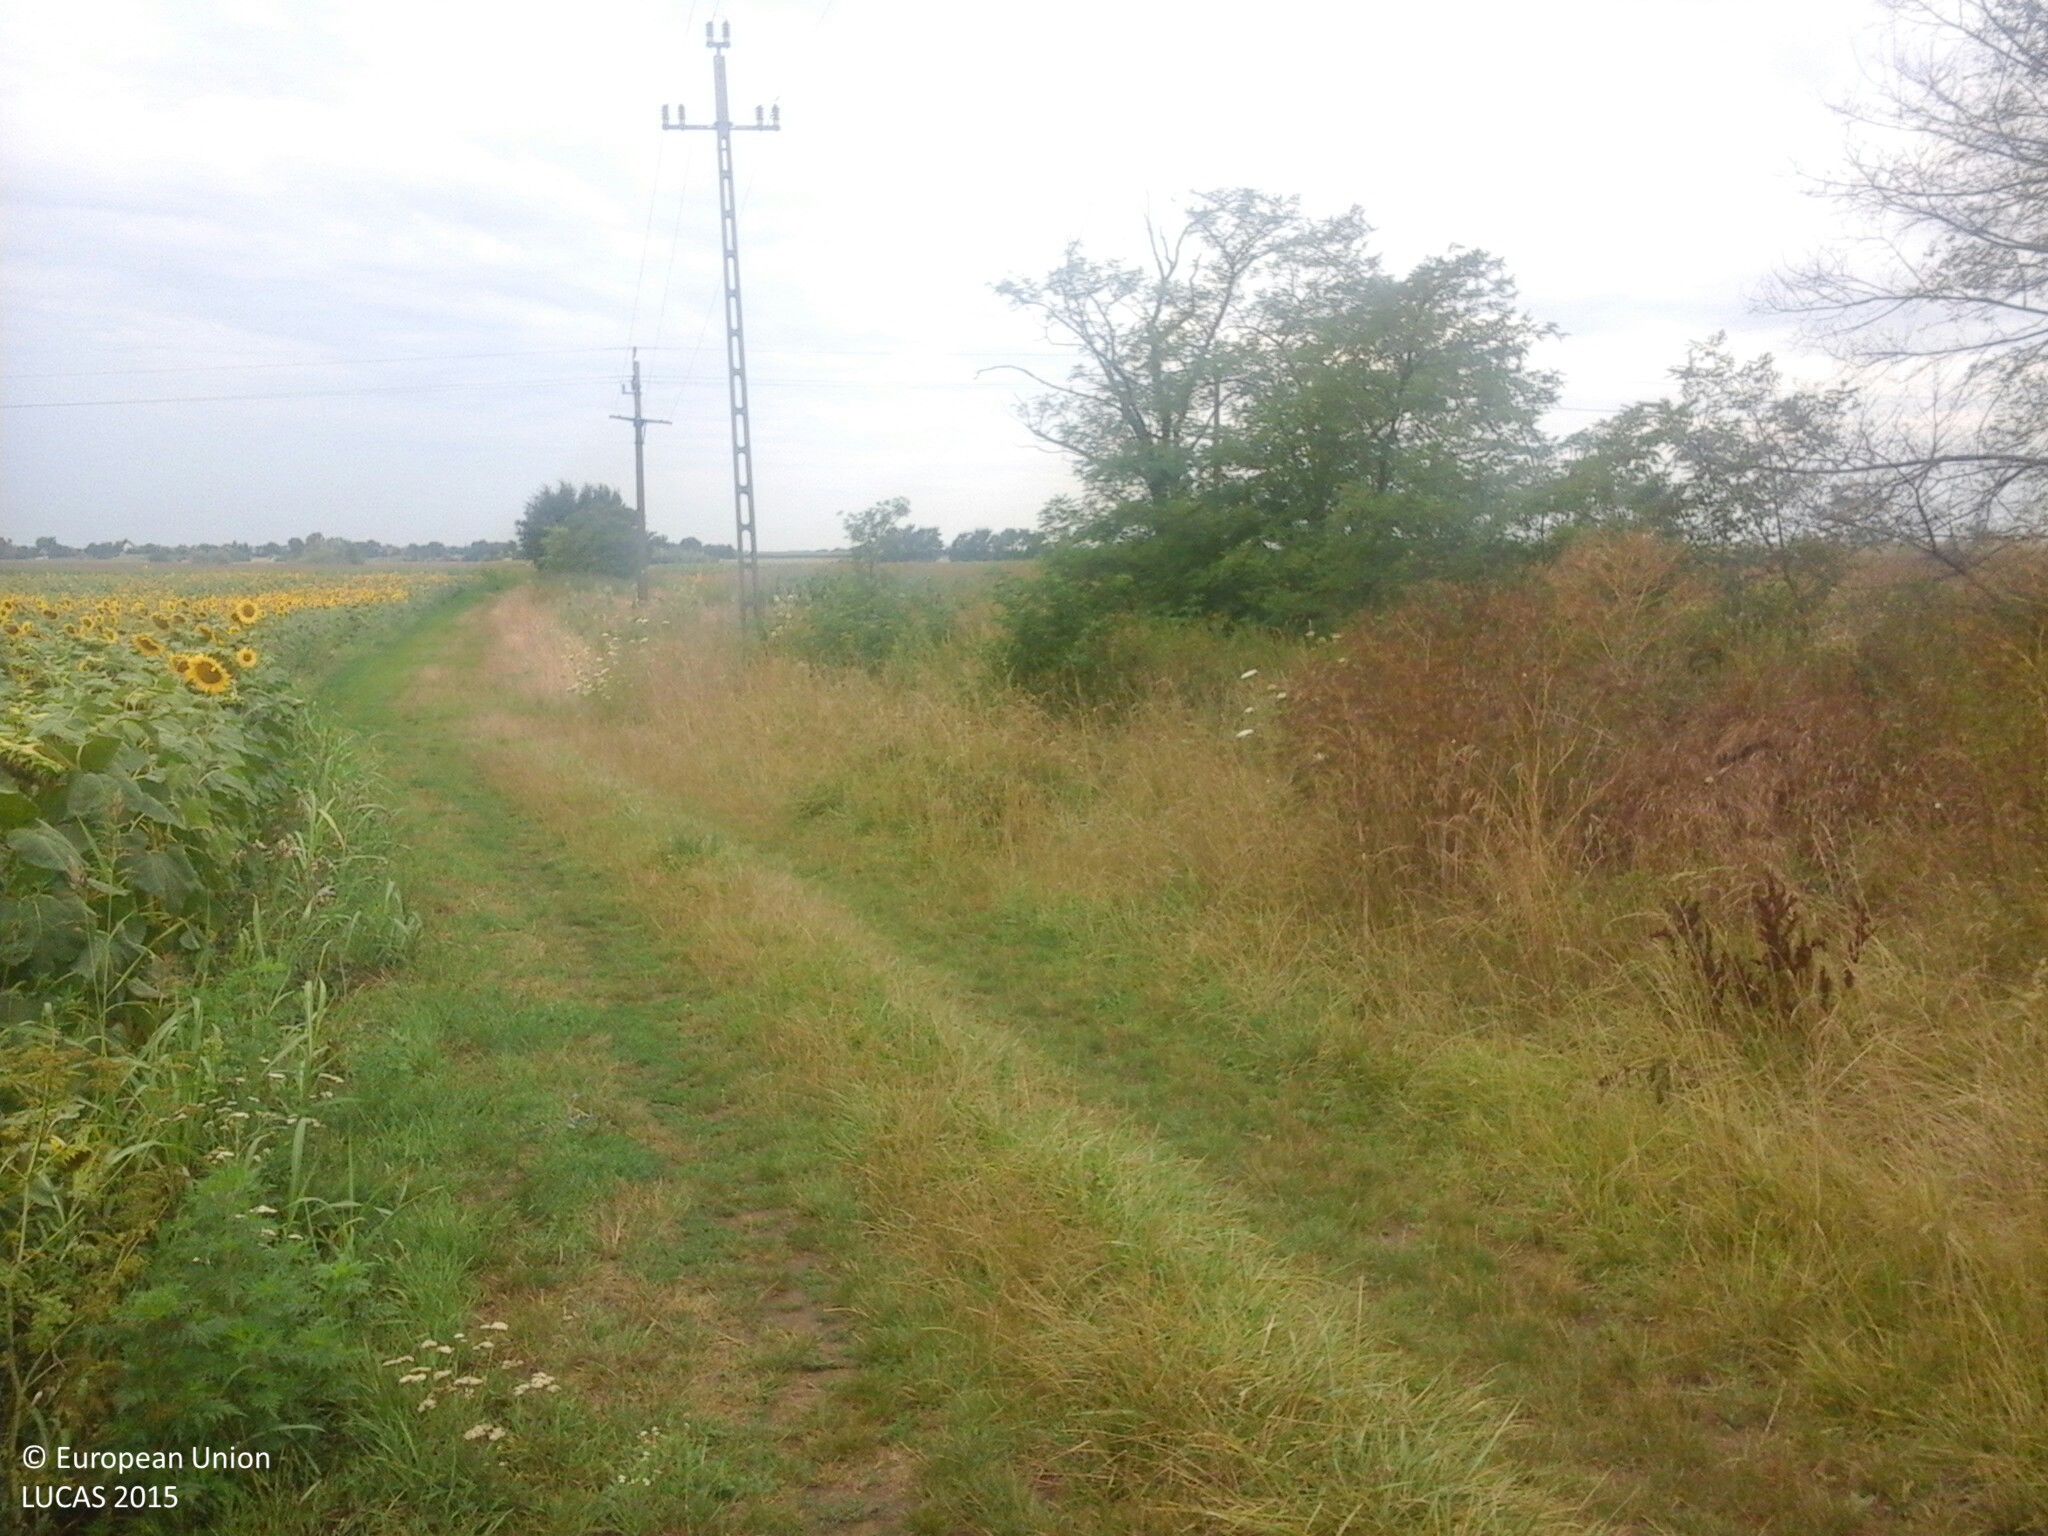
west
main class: Cropland
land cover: Sunflower
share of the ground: > 75 %
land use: Agriculture (excluding fallow land and kitchen gardens)
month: July
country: HU
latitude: 47.0503
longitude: 18.4233
